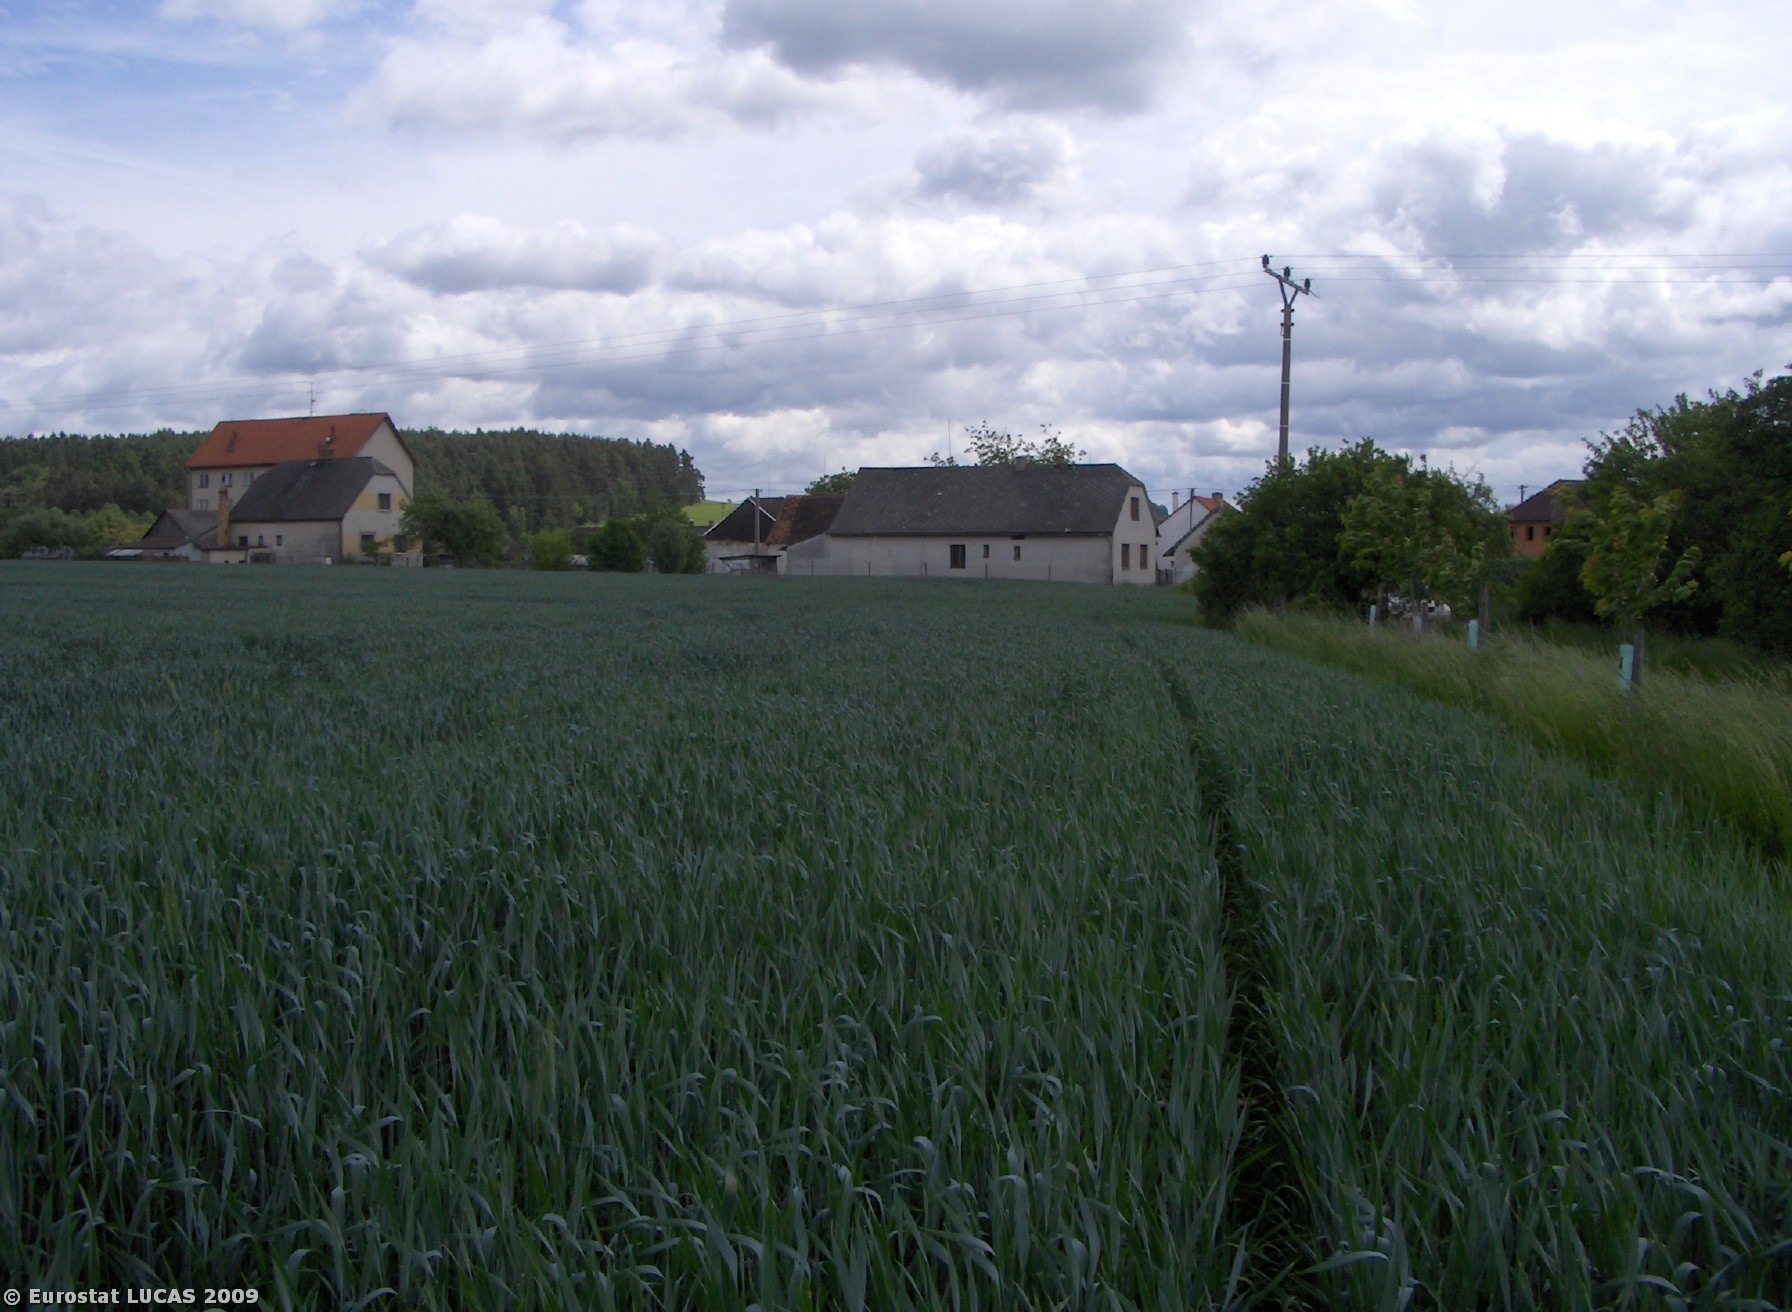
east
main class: Cropland
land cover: Common wheat
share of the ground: > 75 %
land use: Agriculture (excluding fallow land and kitchen gardens)
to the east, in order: Common wheat; Electric lines; Common wheat; Grass margins; Fences; Artificial constructions in urban areas
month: May
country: CZ
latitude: 49.3274
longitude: 14.3353
